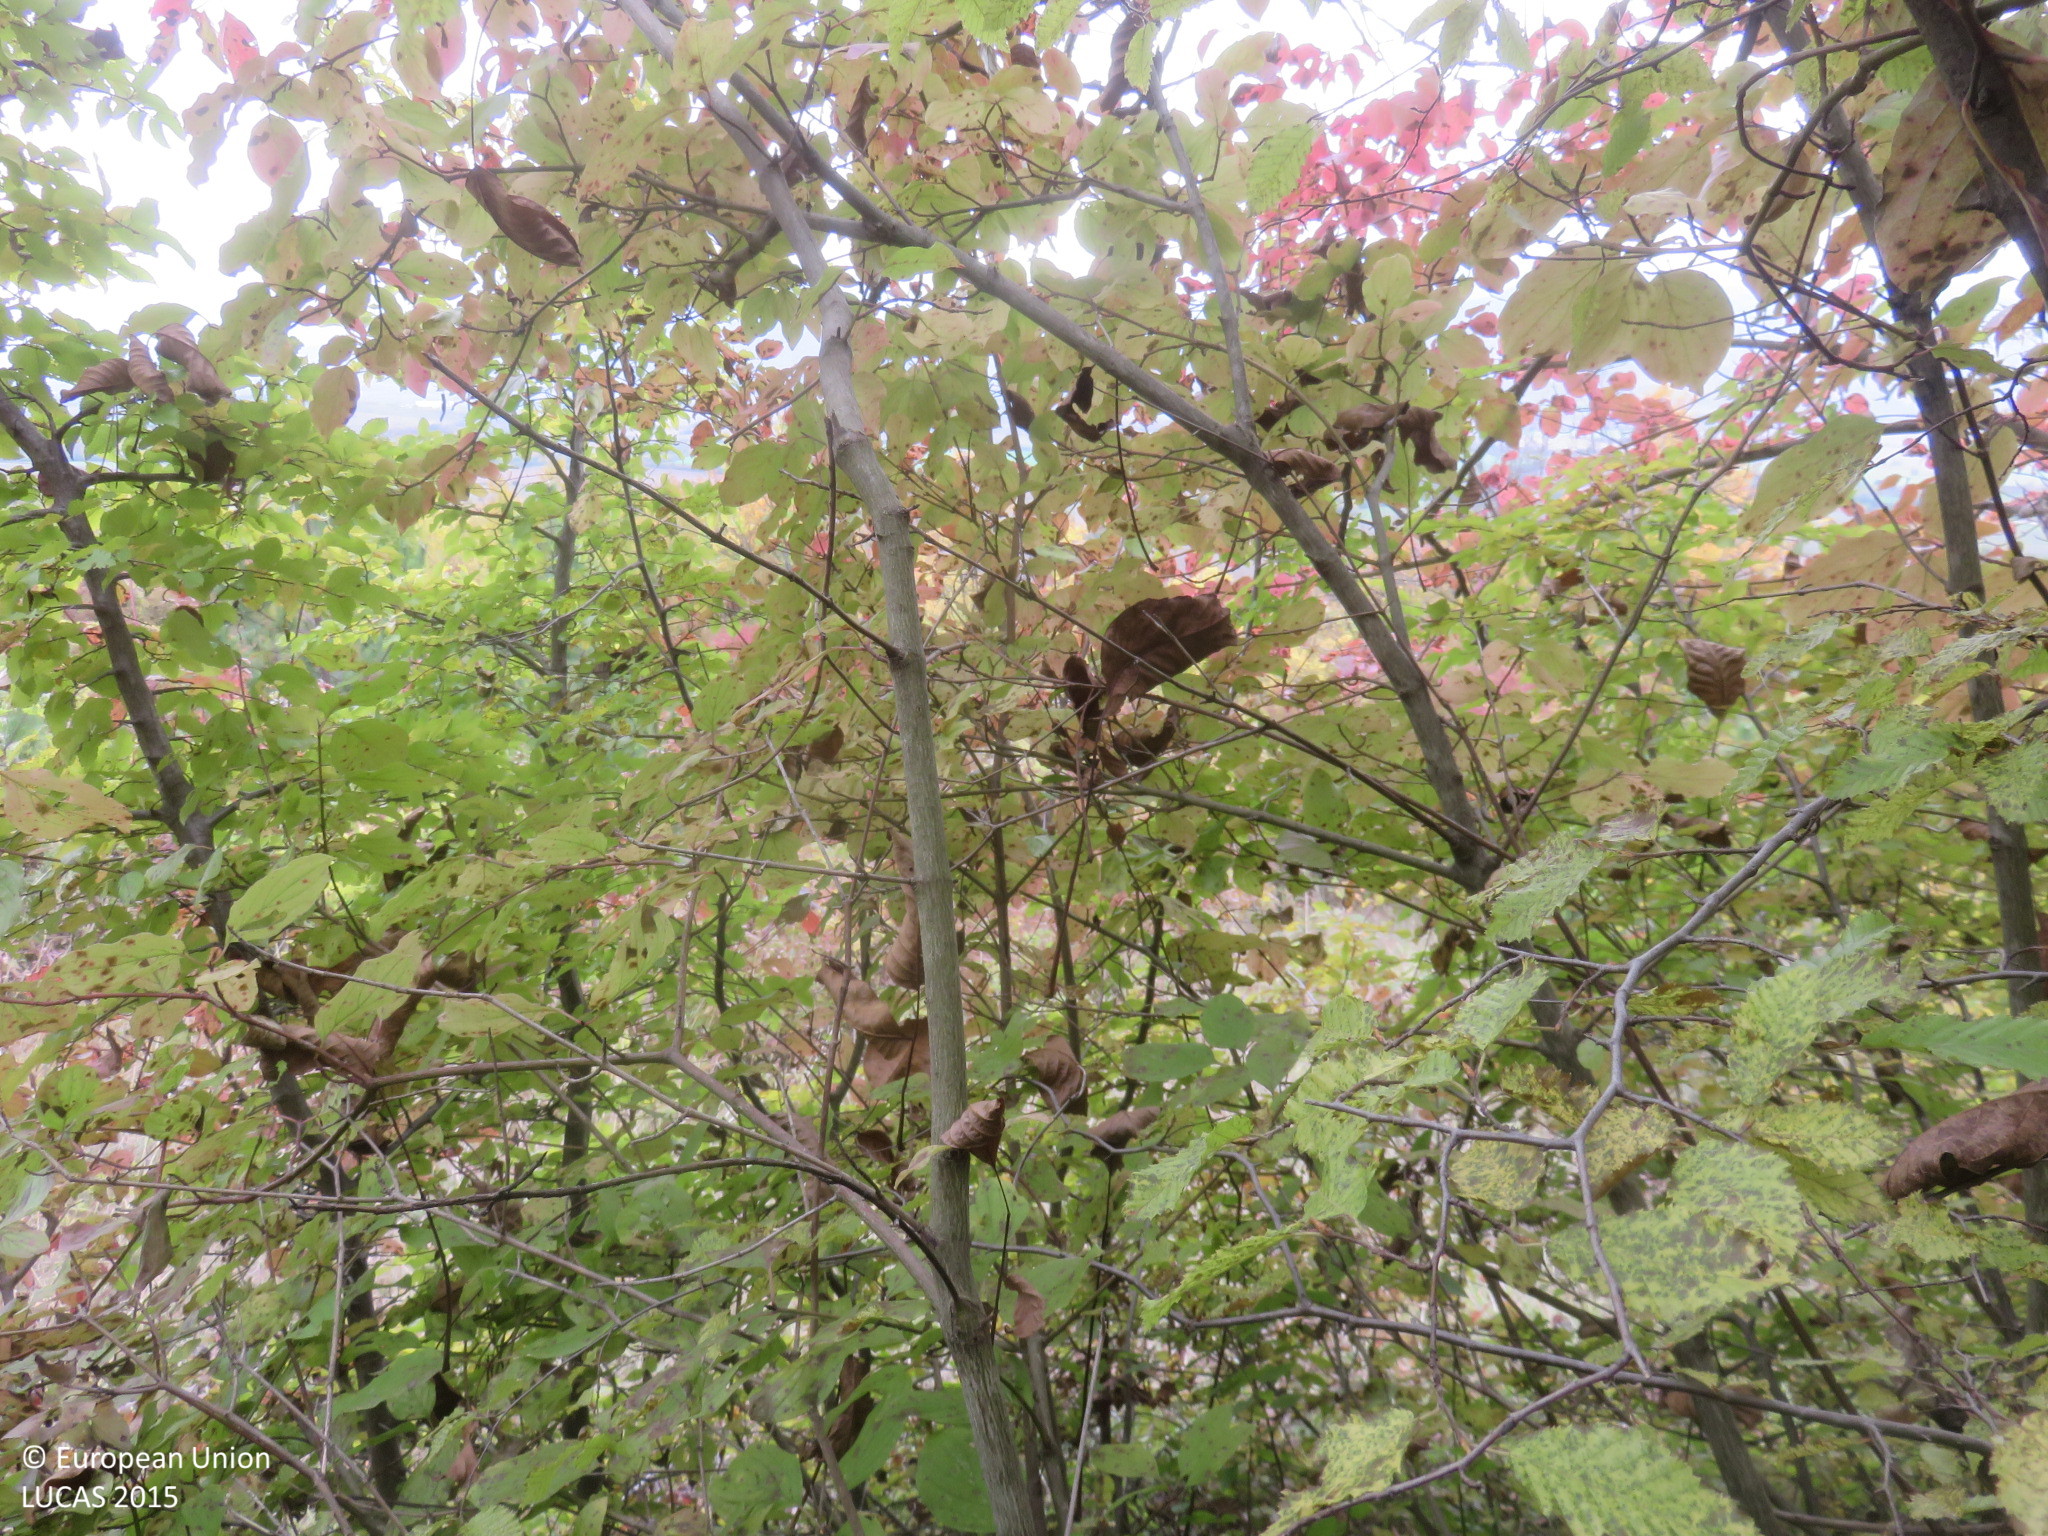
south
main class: Shrubland
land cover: Shrubland with sparse tree cover
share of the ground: > 75 %
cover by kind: shrubs 95 %, broadleaved forest trees 5 %
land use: Semi-natural and natural areas not in use
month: October
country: BG
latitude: 43.0044
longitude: 24.9455
